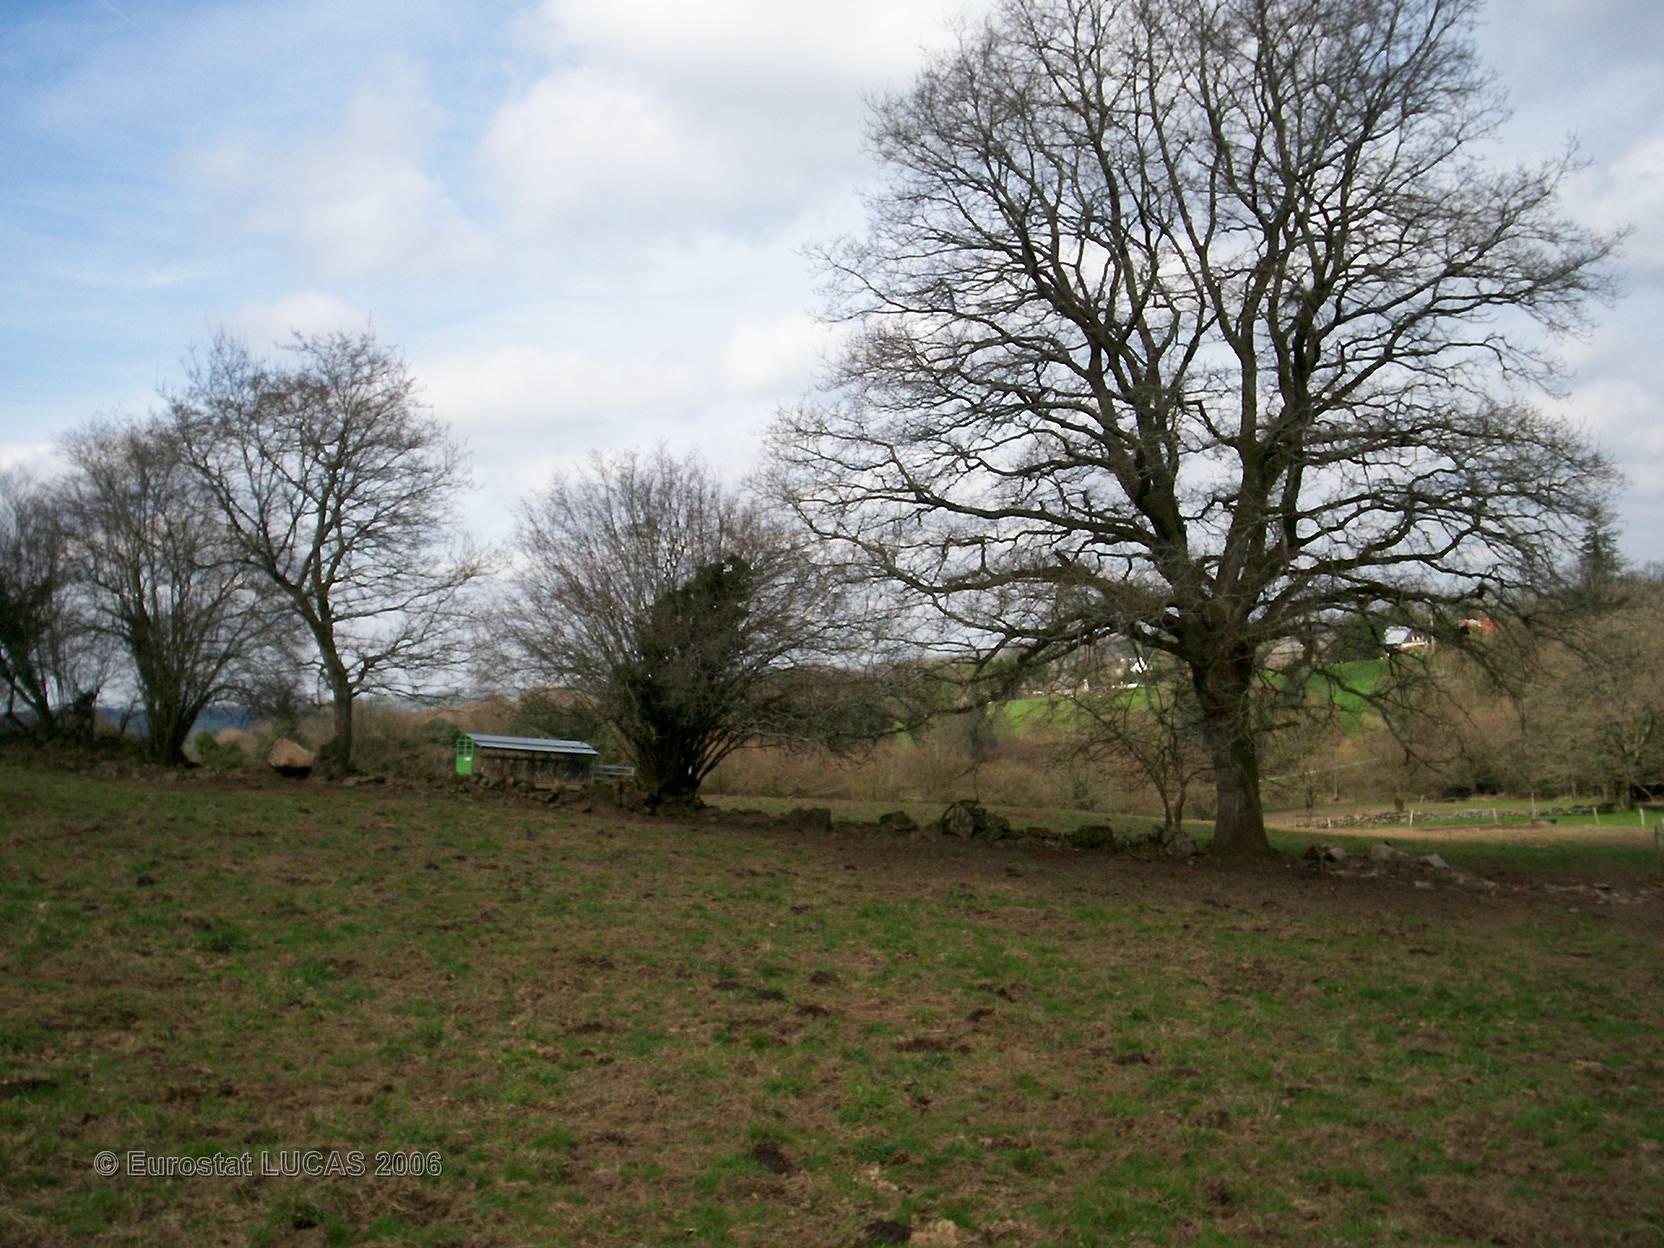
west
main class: Grassland
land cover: Grassland without tree/shrub cover
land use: Agriculture (excluding fallow land and kitchen gardens)
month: April
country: FR
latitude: 48.0590
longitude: -3.5357
